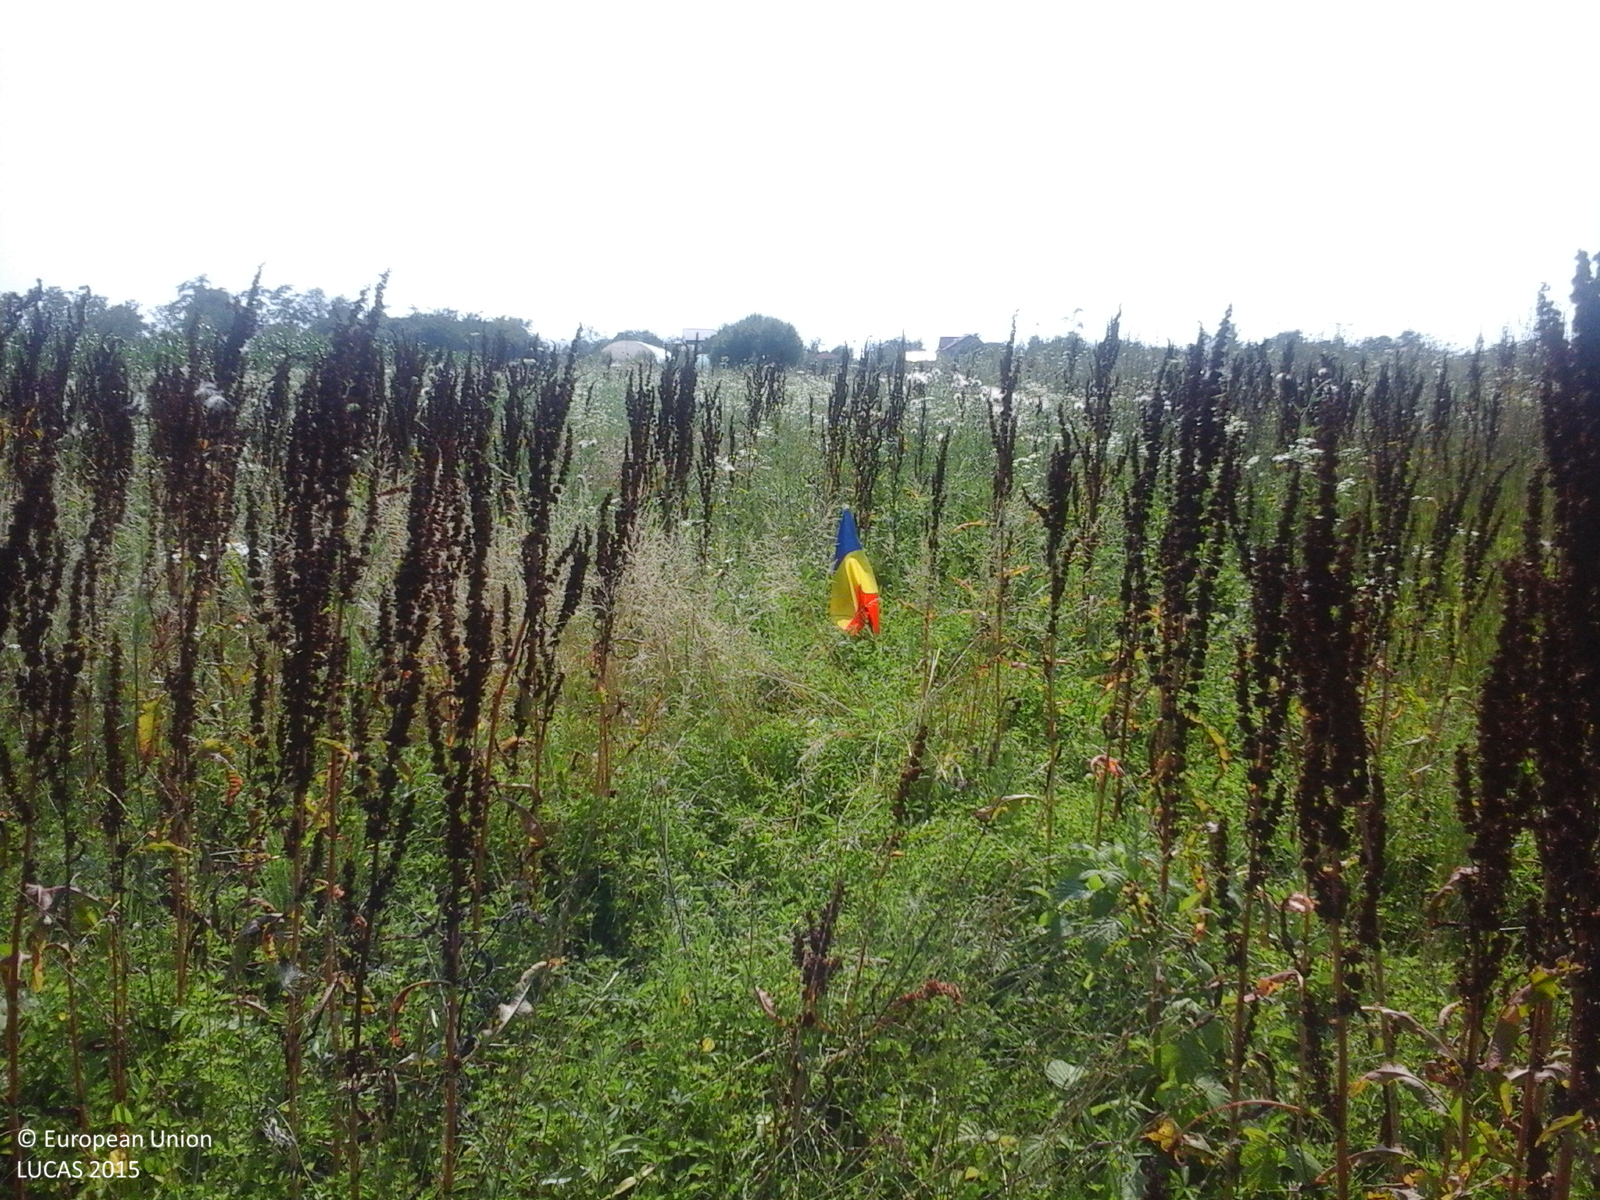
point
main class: Grassland
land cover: Spontaneously vegetated surfaces
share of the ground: > 75 %
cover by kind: herbaceous plants 100 %
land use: Fallow land
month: July
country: RO
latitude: 44.6750
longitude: 25.4186
